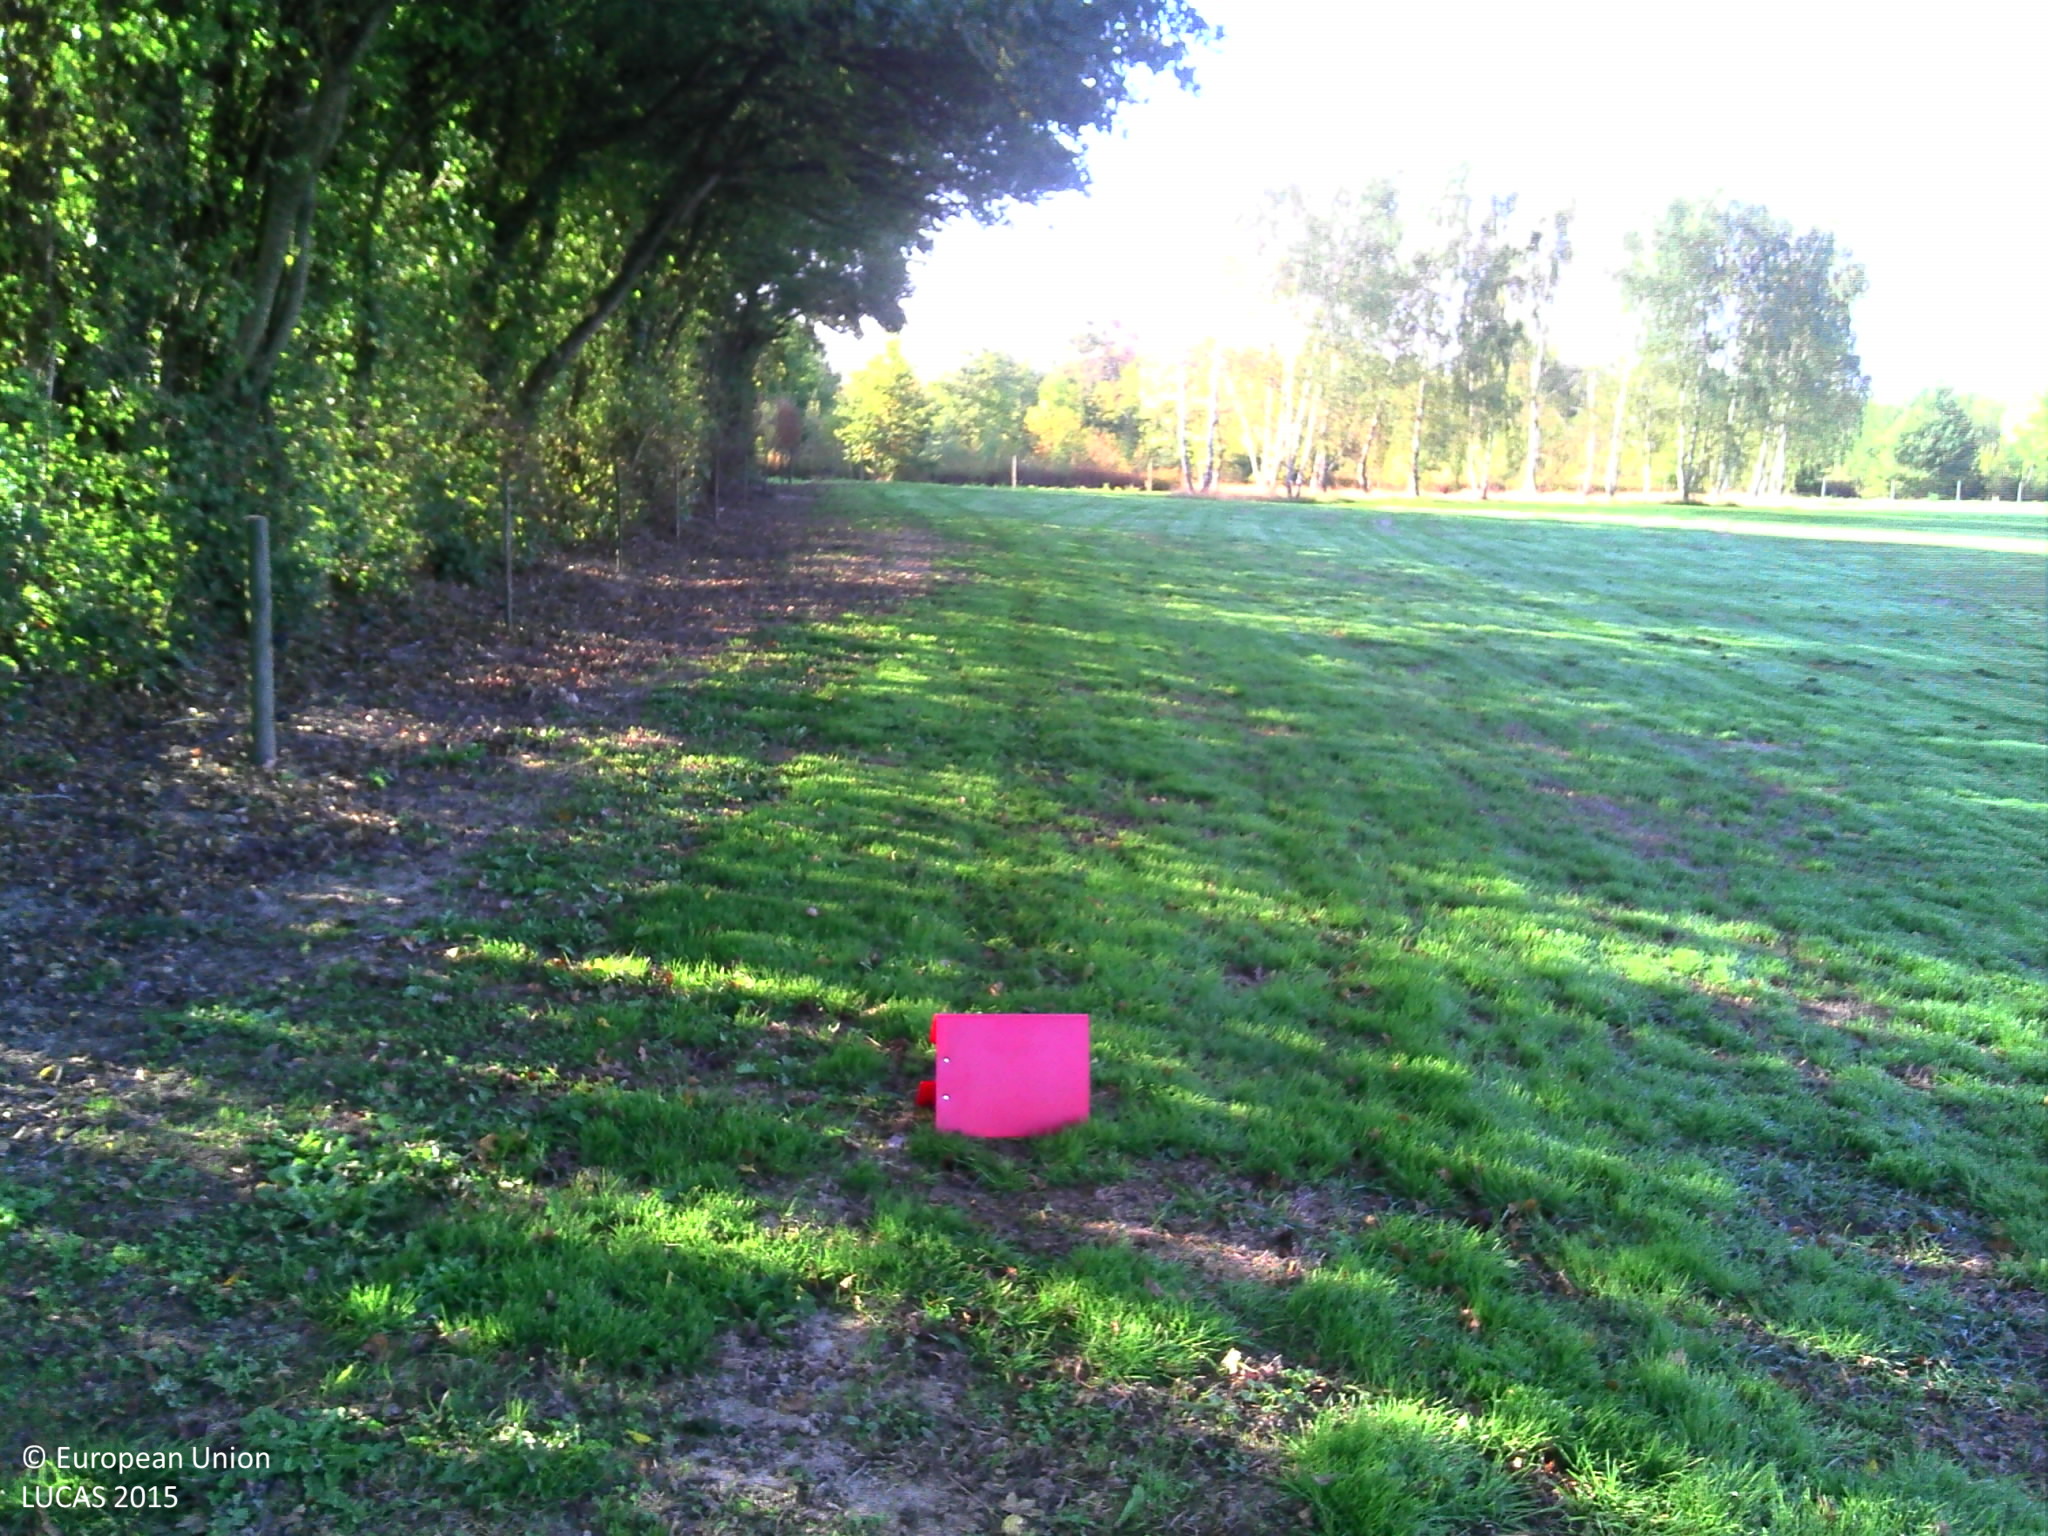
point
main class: Cropland
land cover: Temporary grasslands
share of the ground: > 75 %
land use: Agriculture (excluding fallow land and kitchen gardens)
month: October
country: FR
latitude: 45.9604
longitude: 4.9322
